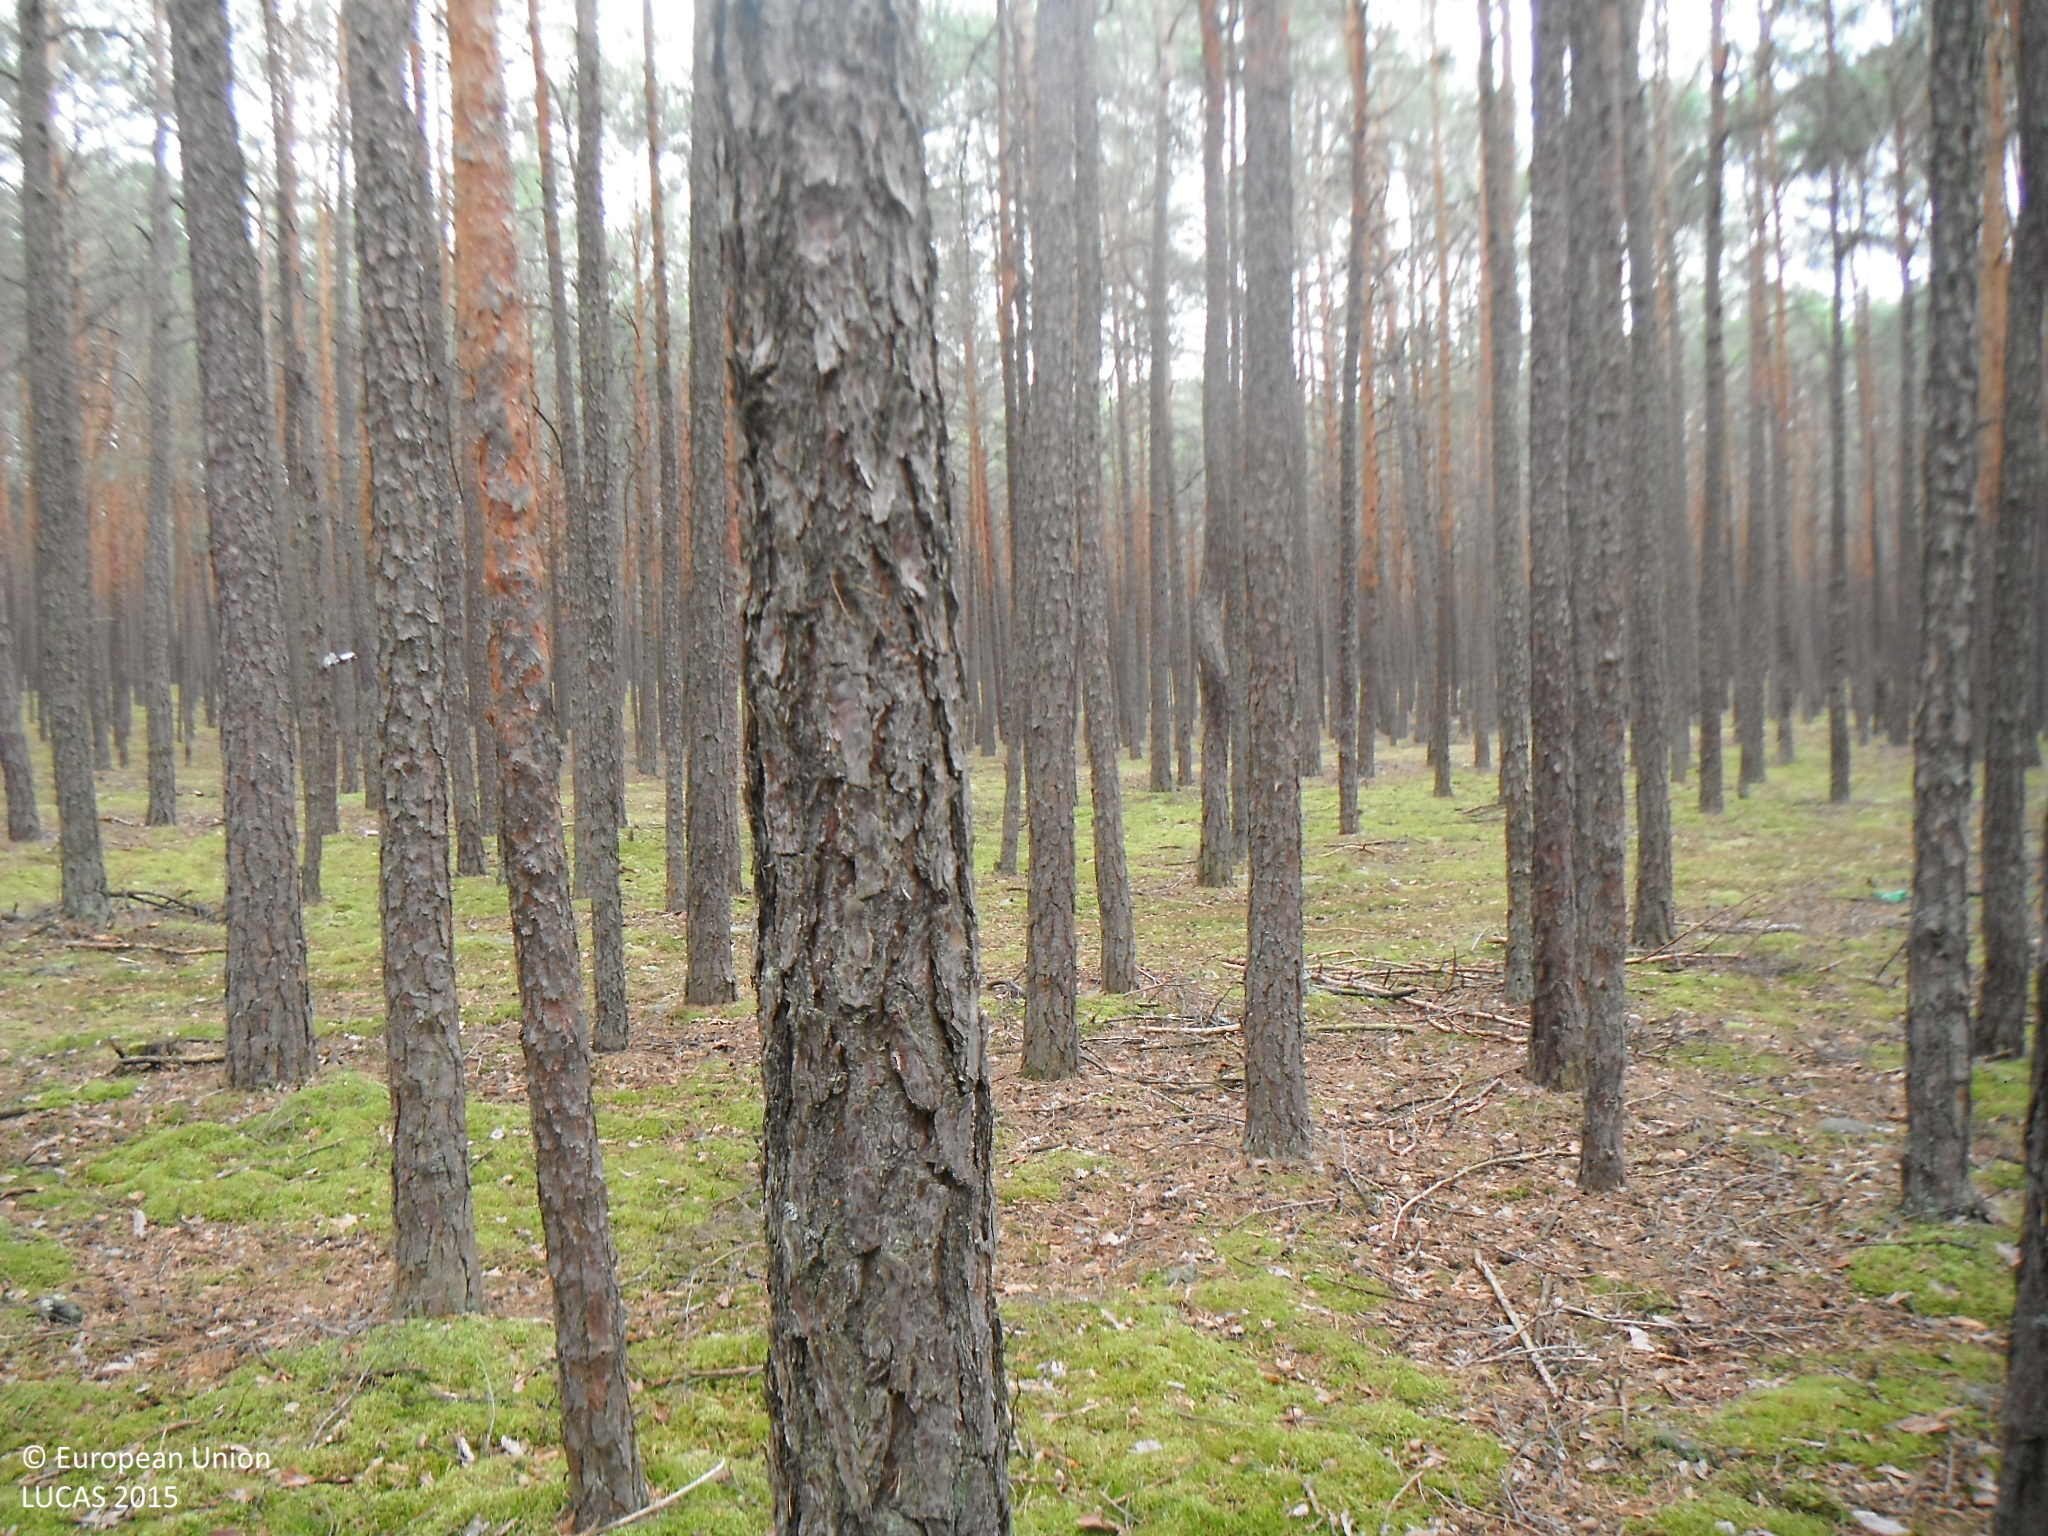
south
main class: Woodland
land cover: Pine dominated coniferous woodland
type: hemiboreal forest and nemoral coniferous forest and mixed broadleaved-coniferous forest
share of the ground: > 75 %
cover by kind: coniferous forest trees 80 %, lichens and mosses 20 %
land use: Forestry
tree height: > 5 m
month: June
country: SK
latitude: 48.6355
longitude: 17.2423
